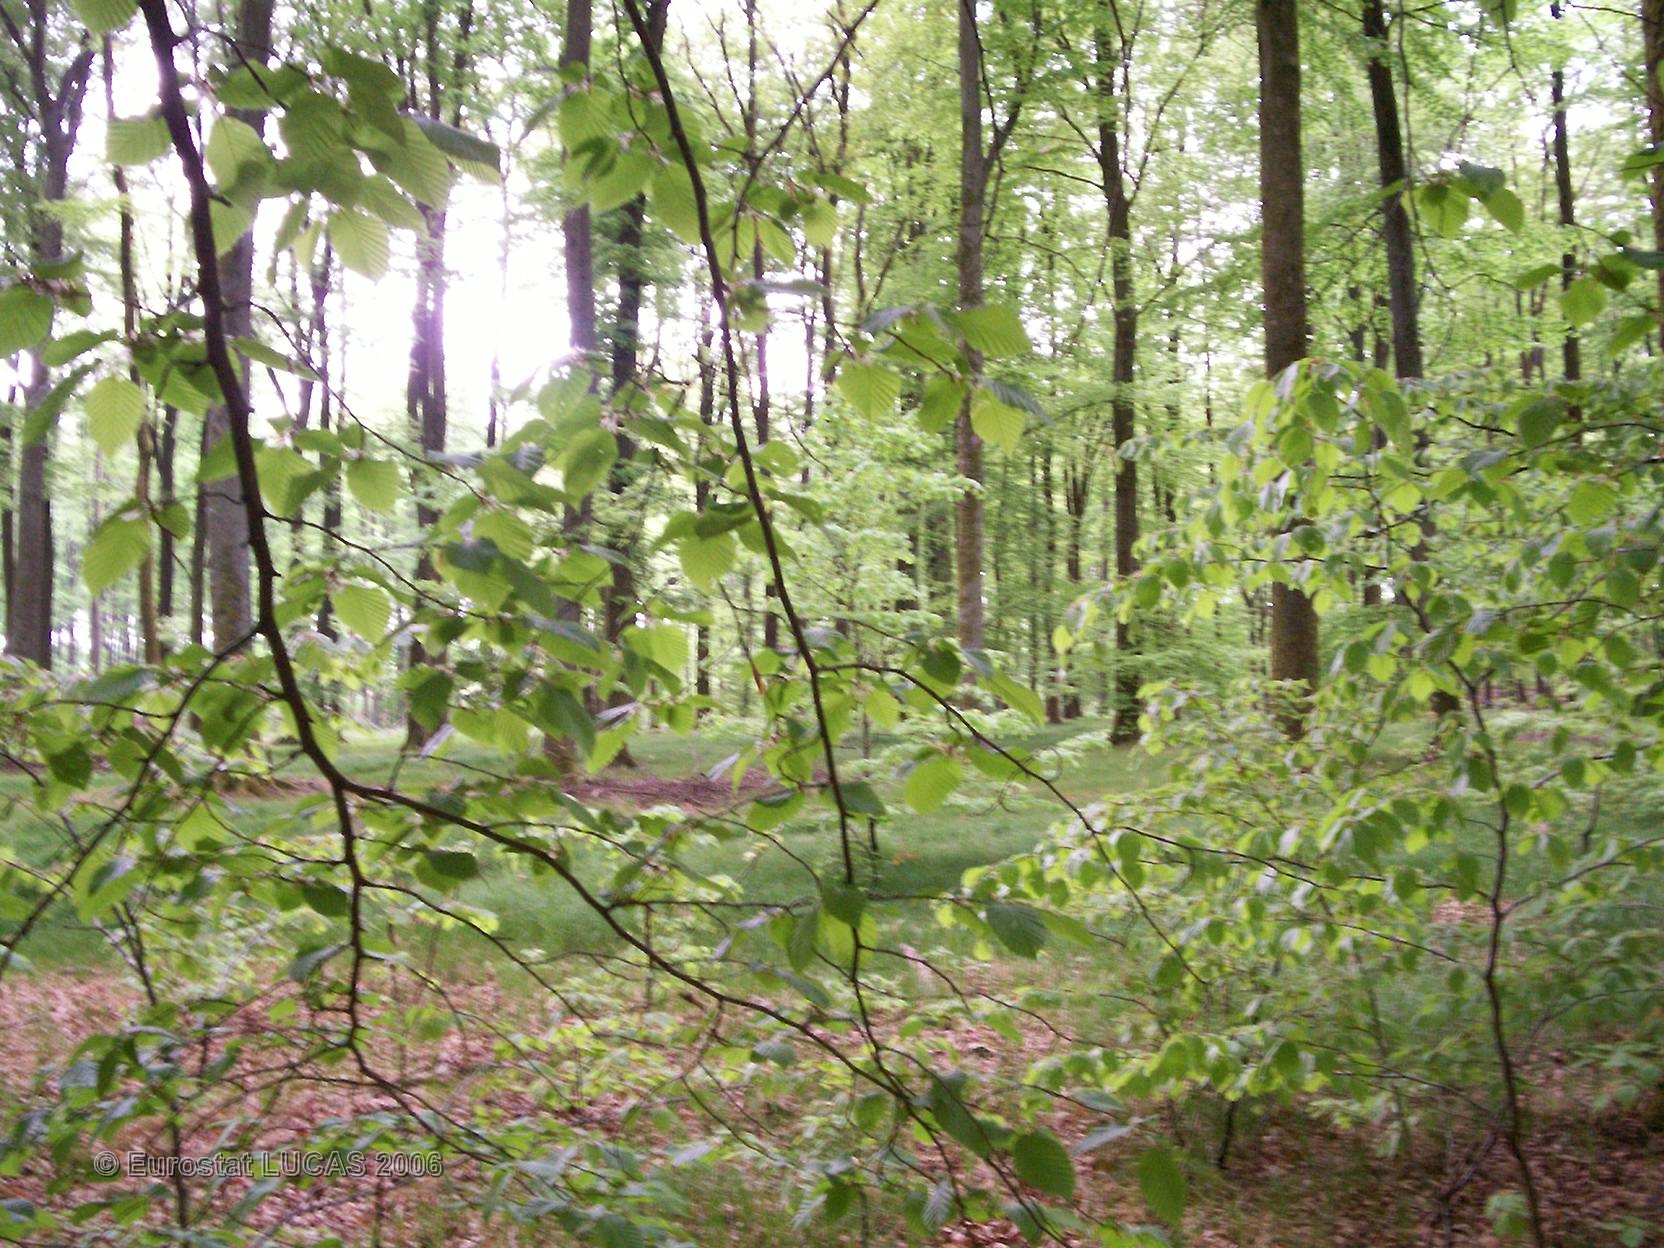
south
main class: Woodland
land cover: Broadleaved forest
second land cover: Grassland with sparse tree/shrub cover
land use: Forestry
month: May
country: FR
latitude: 47.7354
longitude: 7.1078
